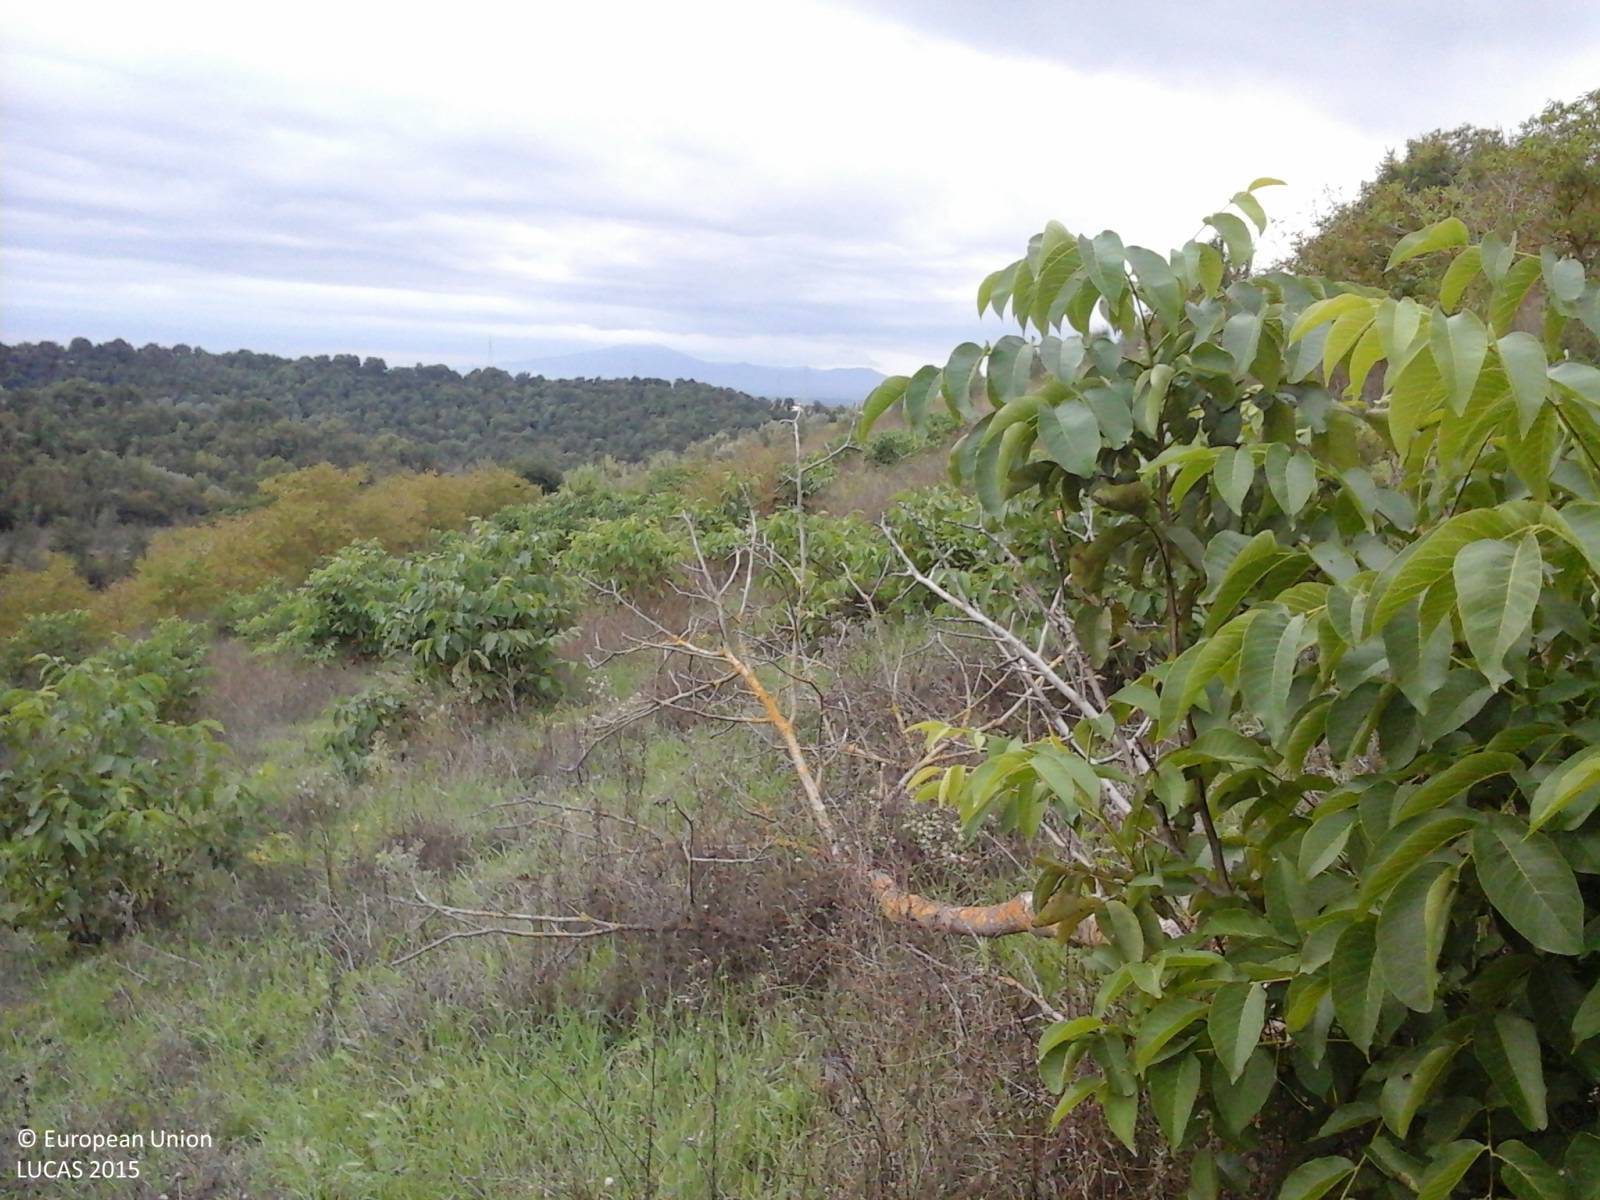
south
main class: Cropland
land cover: Nuts trees
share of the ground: 50 - 75 %
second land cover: Spontaneously vegetated surfaces
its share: > 75 %
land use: Agriculture (excluding fallow land and kitchen gardens)
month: October
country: IT
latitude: 42.6652
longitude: 12.2499
